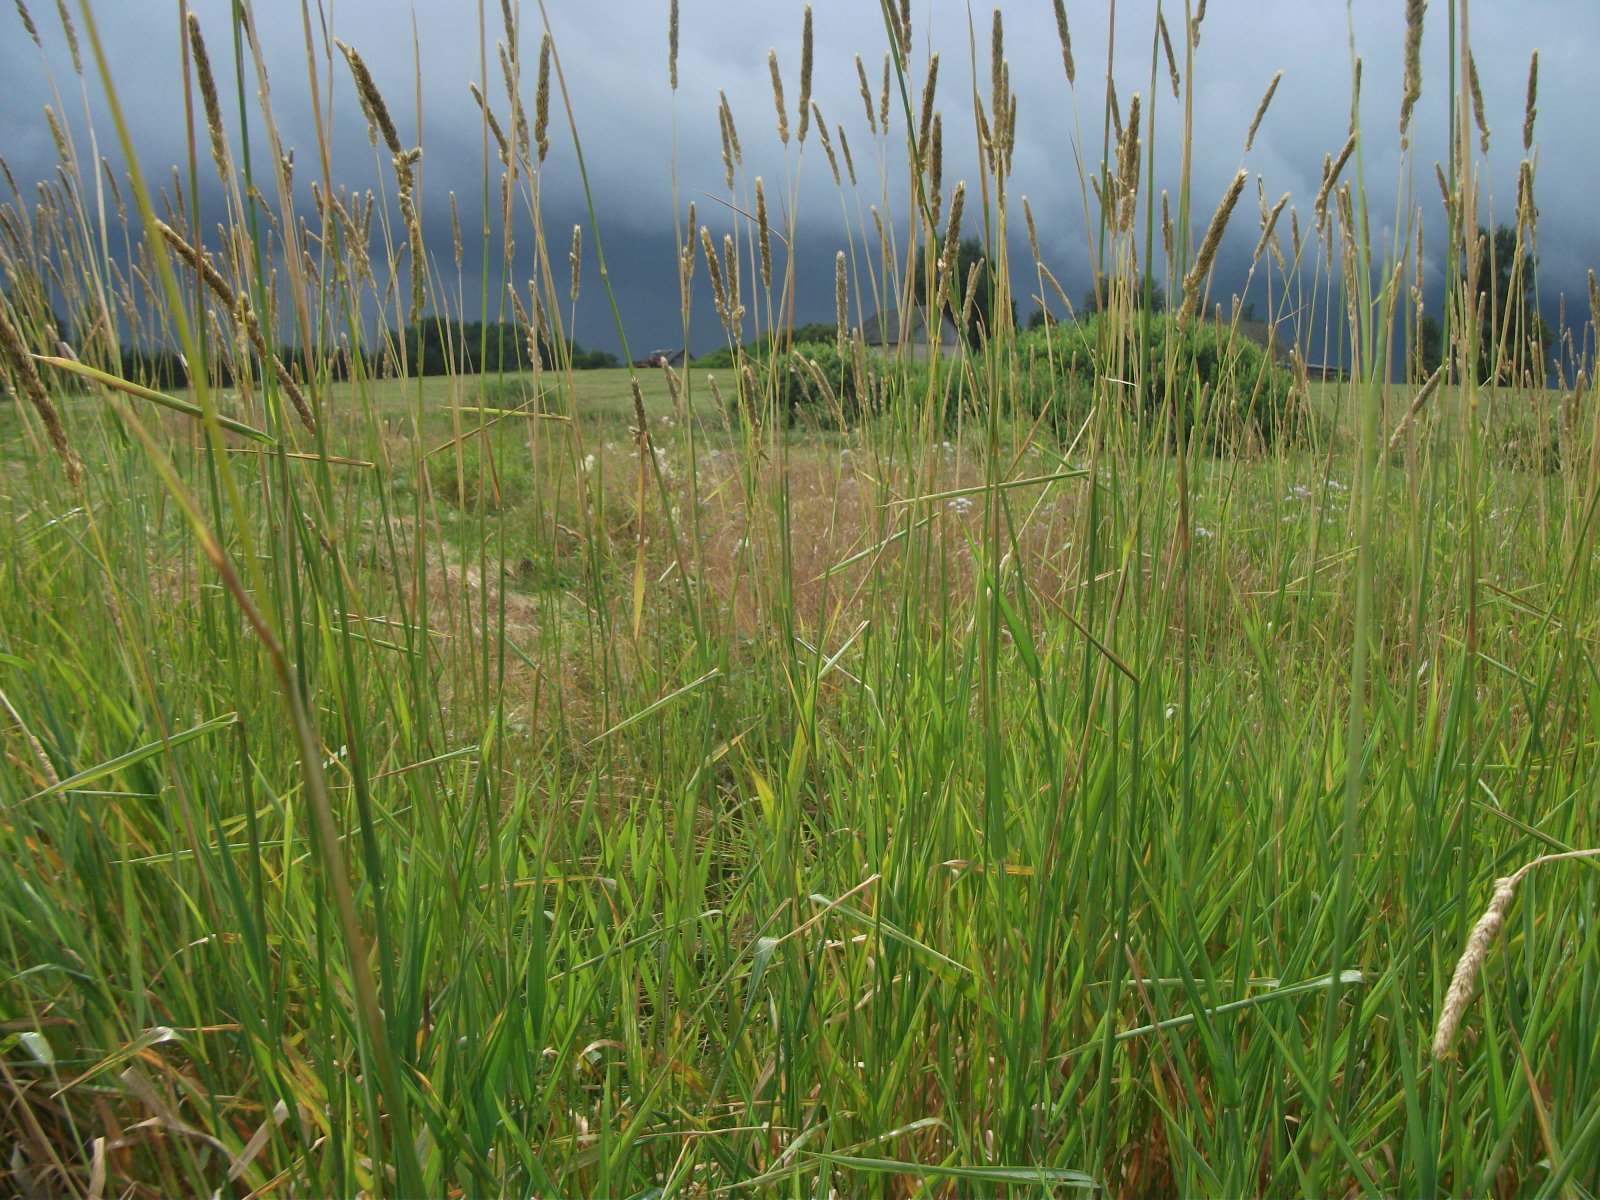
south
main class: Grassland
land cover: Grassland without tree/shrub cover
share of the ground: > 75 %
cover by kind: herbaceous plants 100 %
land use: Agriculture (excluding fallow land and kitchen gardens)
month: July
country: LV
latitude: 57.0078
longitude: 25.8860
